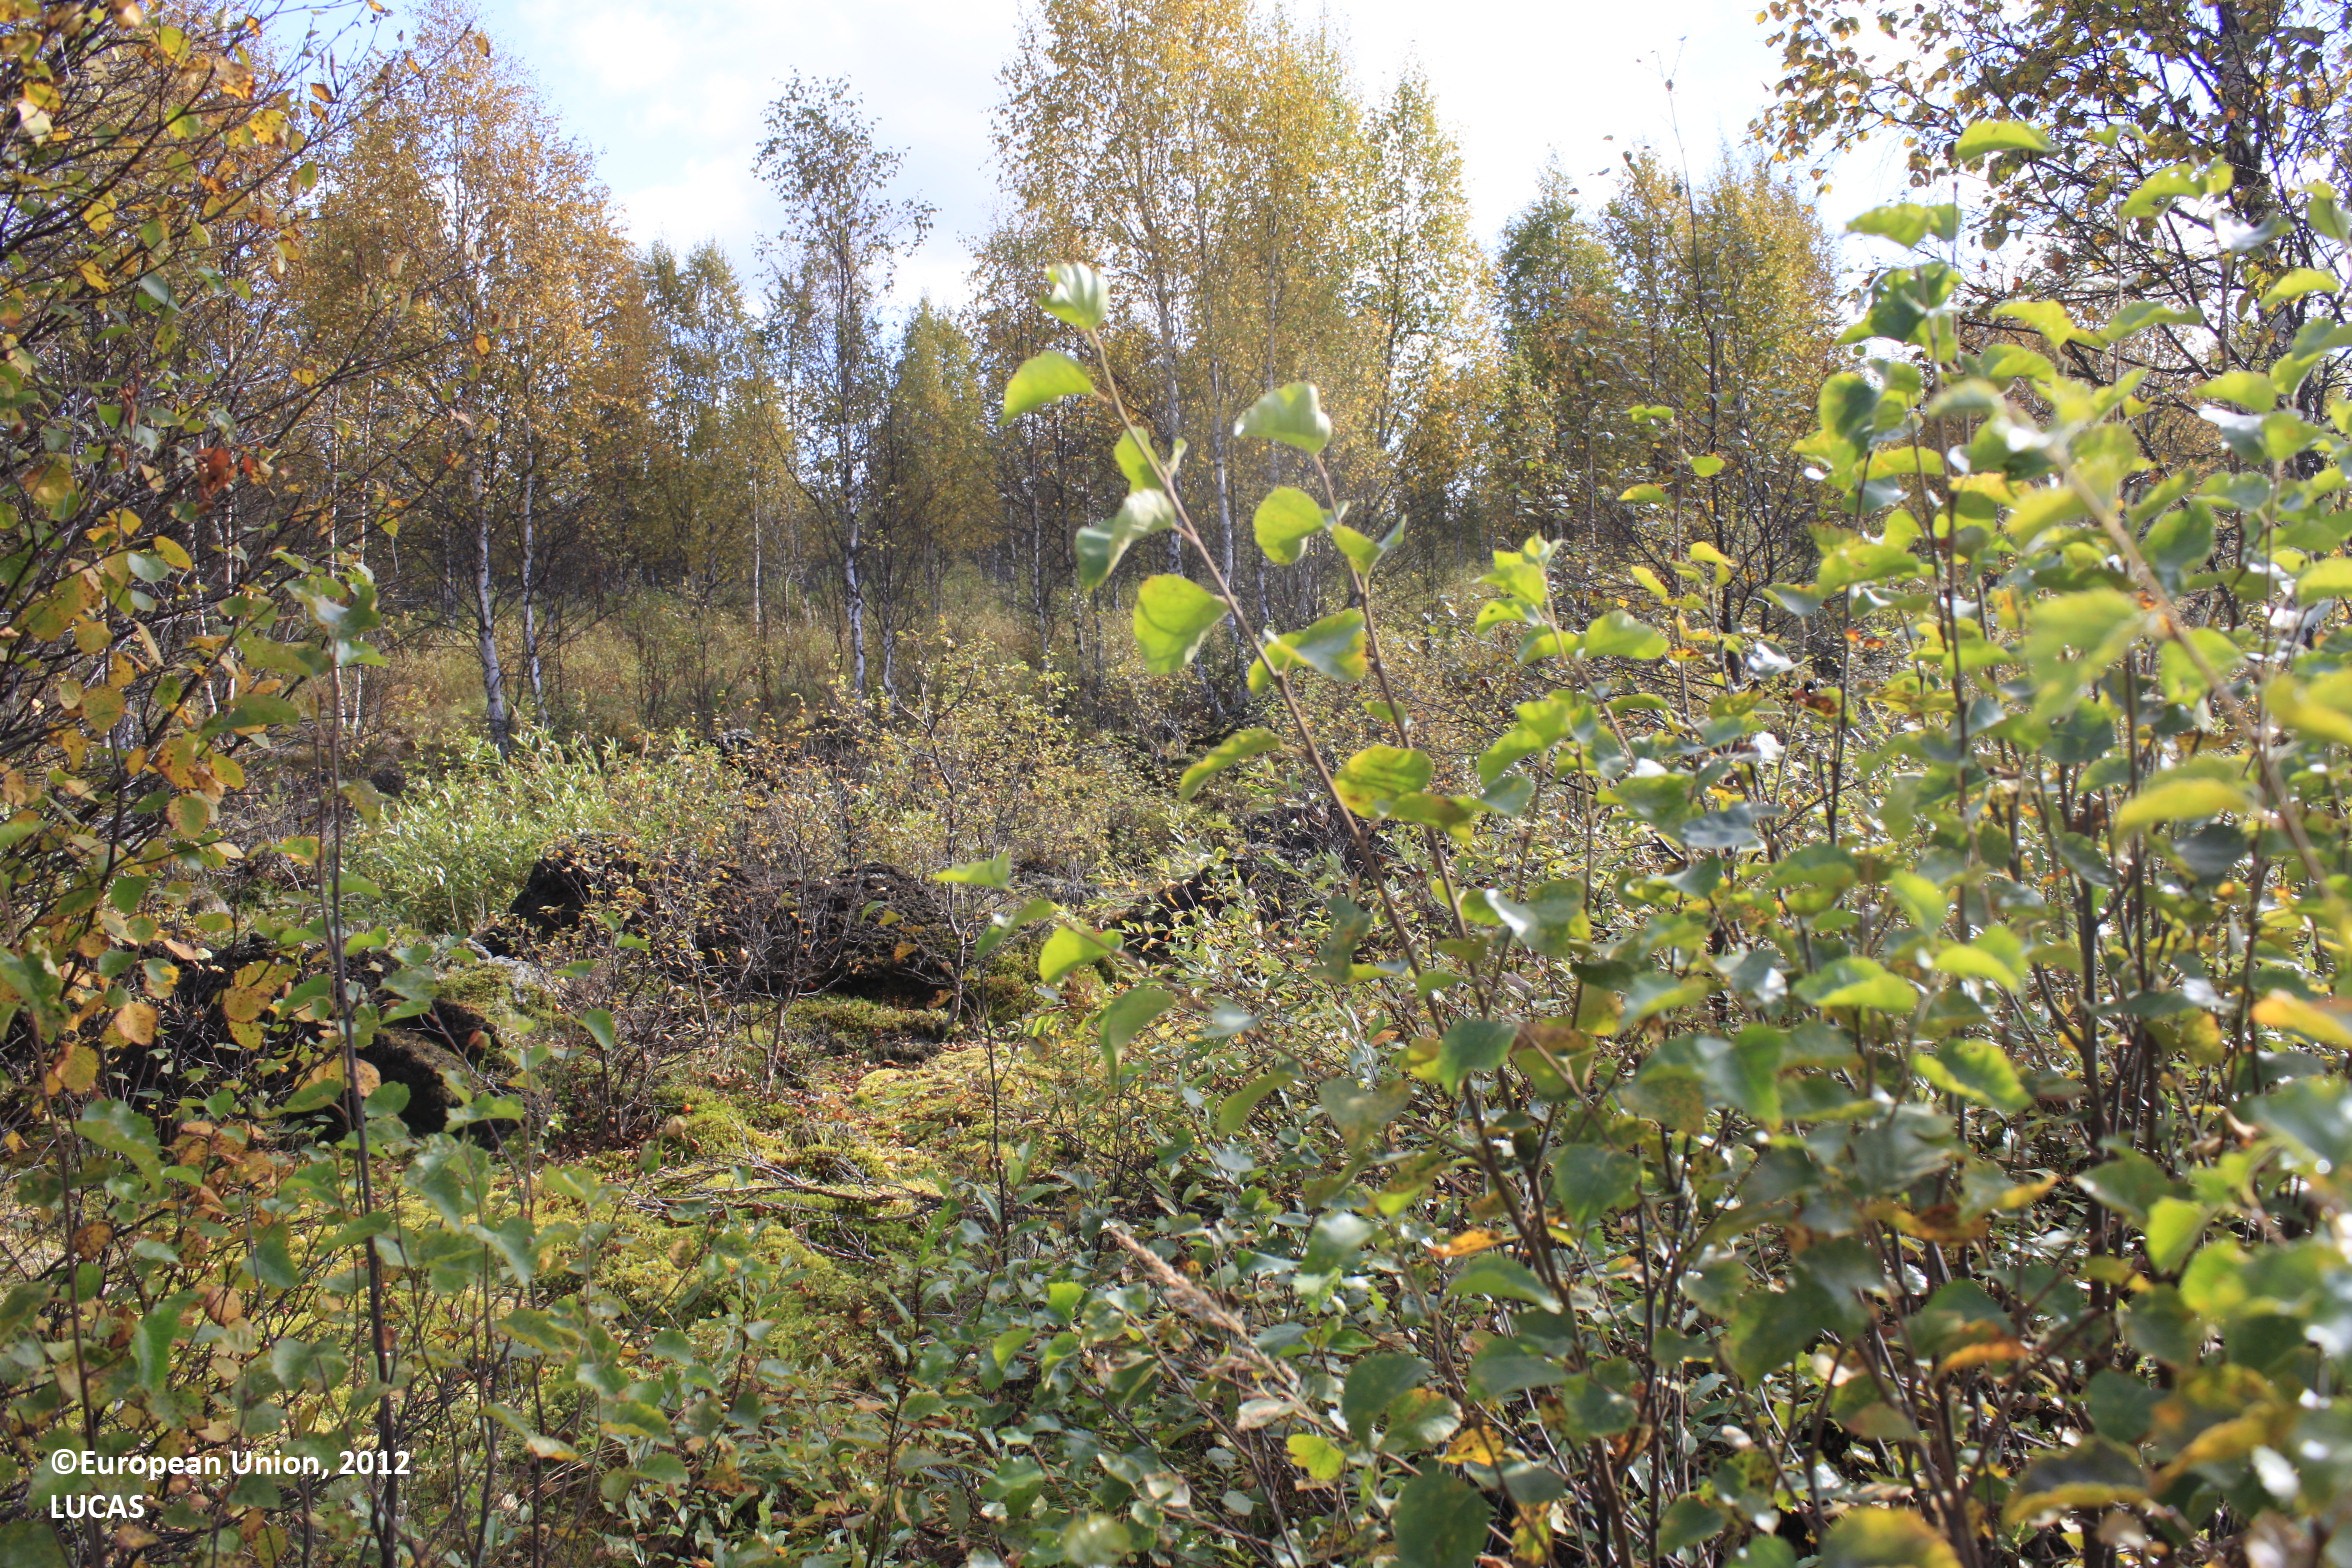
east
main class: Woodland
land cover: Broadleaved woodland
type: boreal forest
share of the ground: 25 - 50 %
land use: Forestry
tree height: < 5 m
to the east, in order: Broadleaved woodland; Ditches and canals; Broadleaved woodland; Ditches and canals; Broadleaved woodland; Ditches and canals; Broadleaved woodland; Ditches and canals; Broadleaved woodland; Ditches and canals; Broadleaved woodland; Ditches and canals; Broadleaved woodland; Ditches and canals; Broadleaved woodland; Ditches and canals; Broadleaved woodland; Ditches and canals; Broadleaved woodland; Ditches and canals; Broadleaved woodland; Ditches and canals; Broadleaved woodland; Ditches and canals; Broadleaved woodland; Ditches and canals; Broadleaved woodland
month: September
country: FI
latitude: 65.6364
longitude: 26.5462
